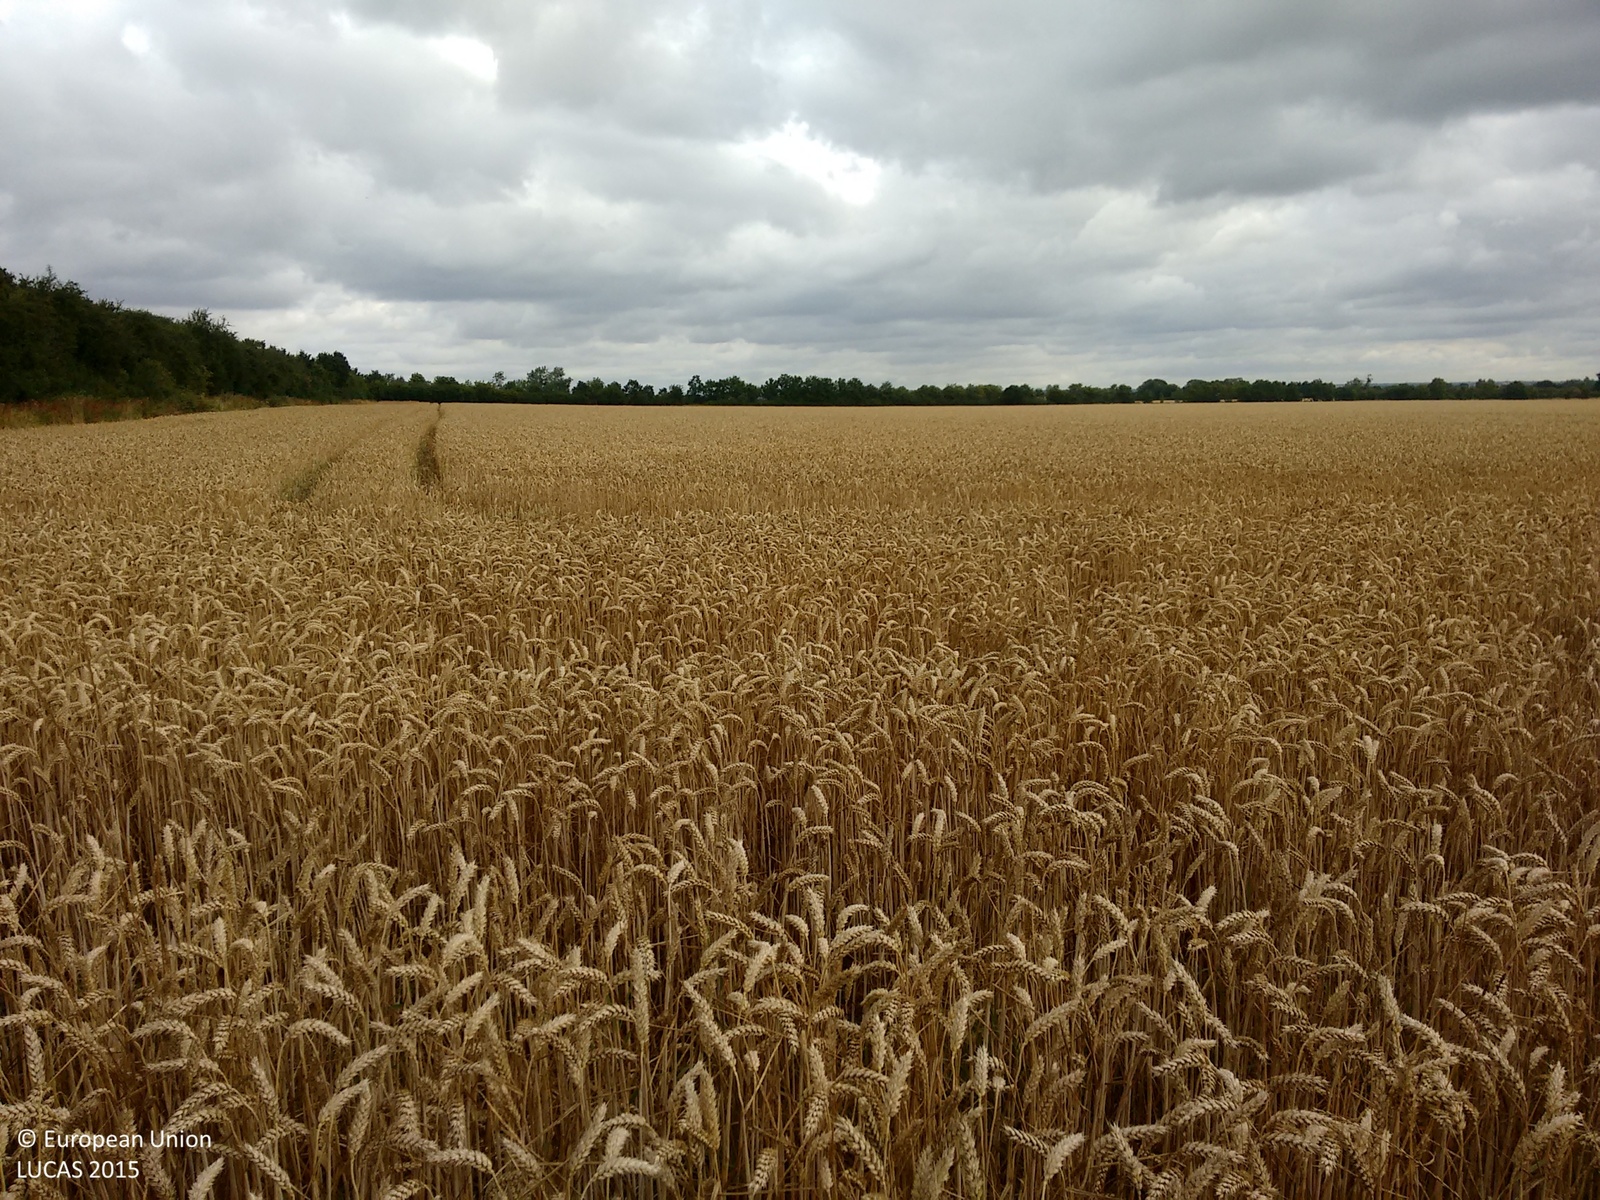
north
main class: Cropland
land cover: Common wheat
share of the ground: > 75 %
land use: Agriculture (excluding fallow land and kitchen gardens)
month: July
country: GB
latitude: 51.6838
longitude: 0.6735
